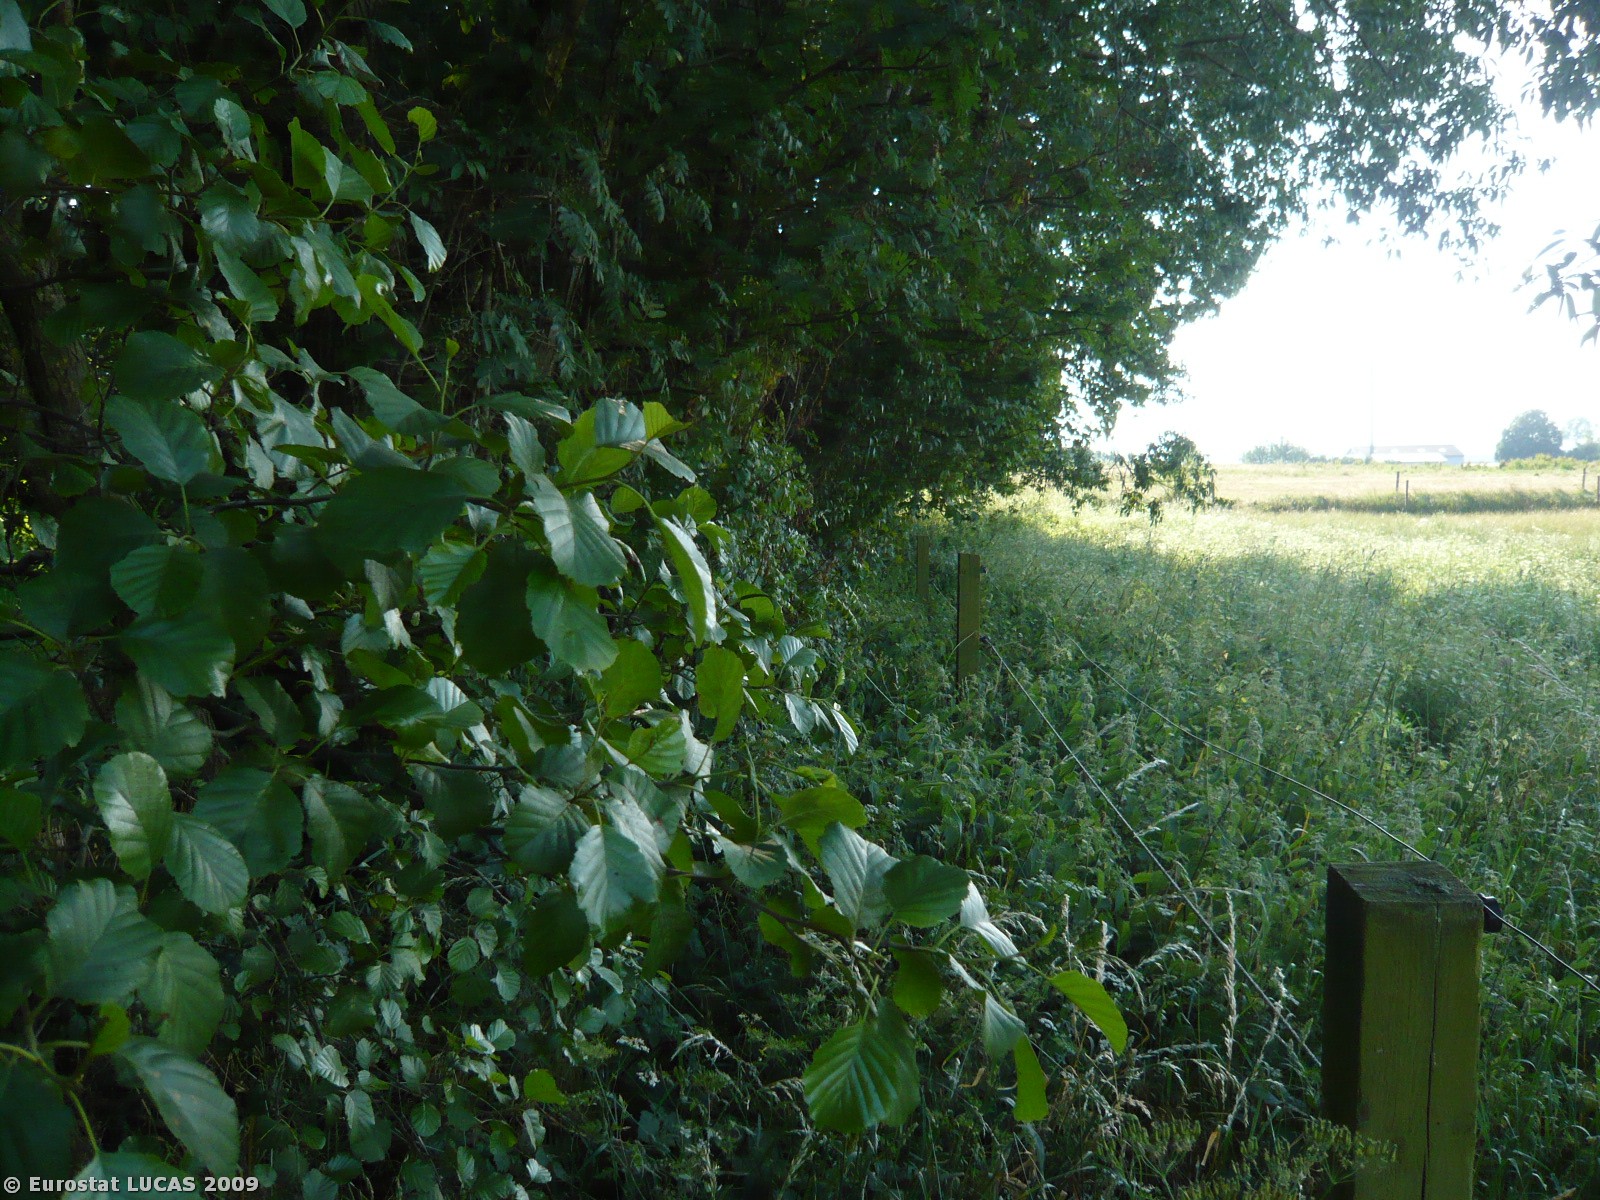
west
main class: Woodland
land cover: Broadleaved woodland
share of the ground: > 75 %
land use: Unused
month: July
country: DK
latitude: 55.4325
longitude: 10.2684
